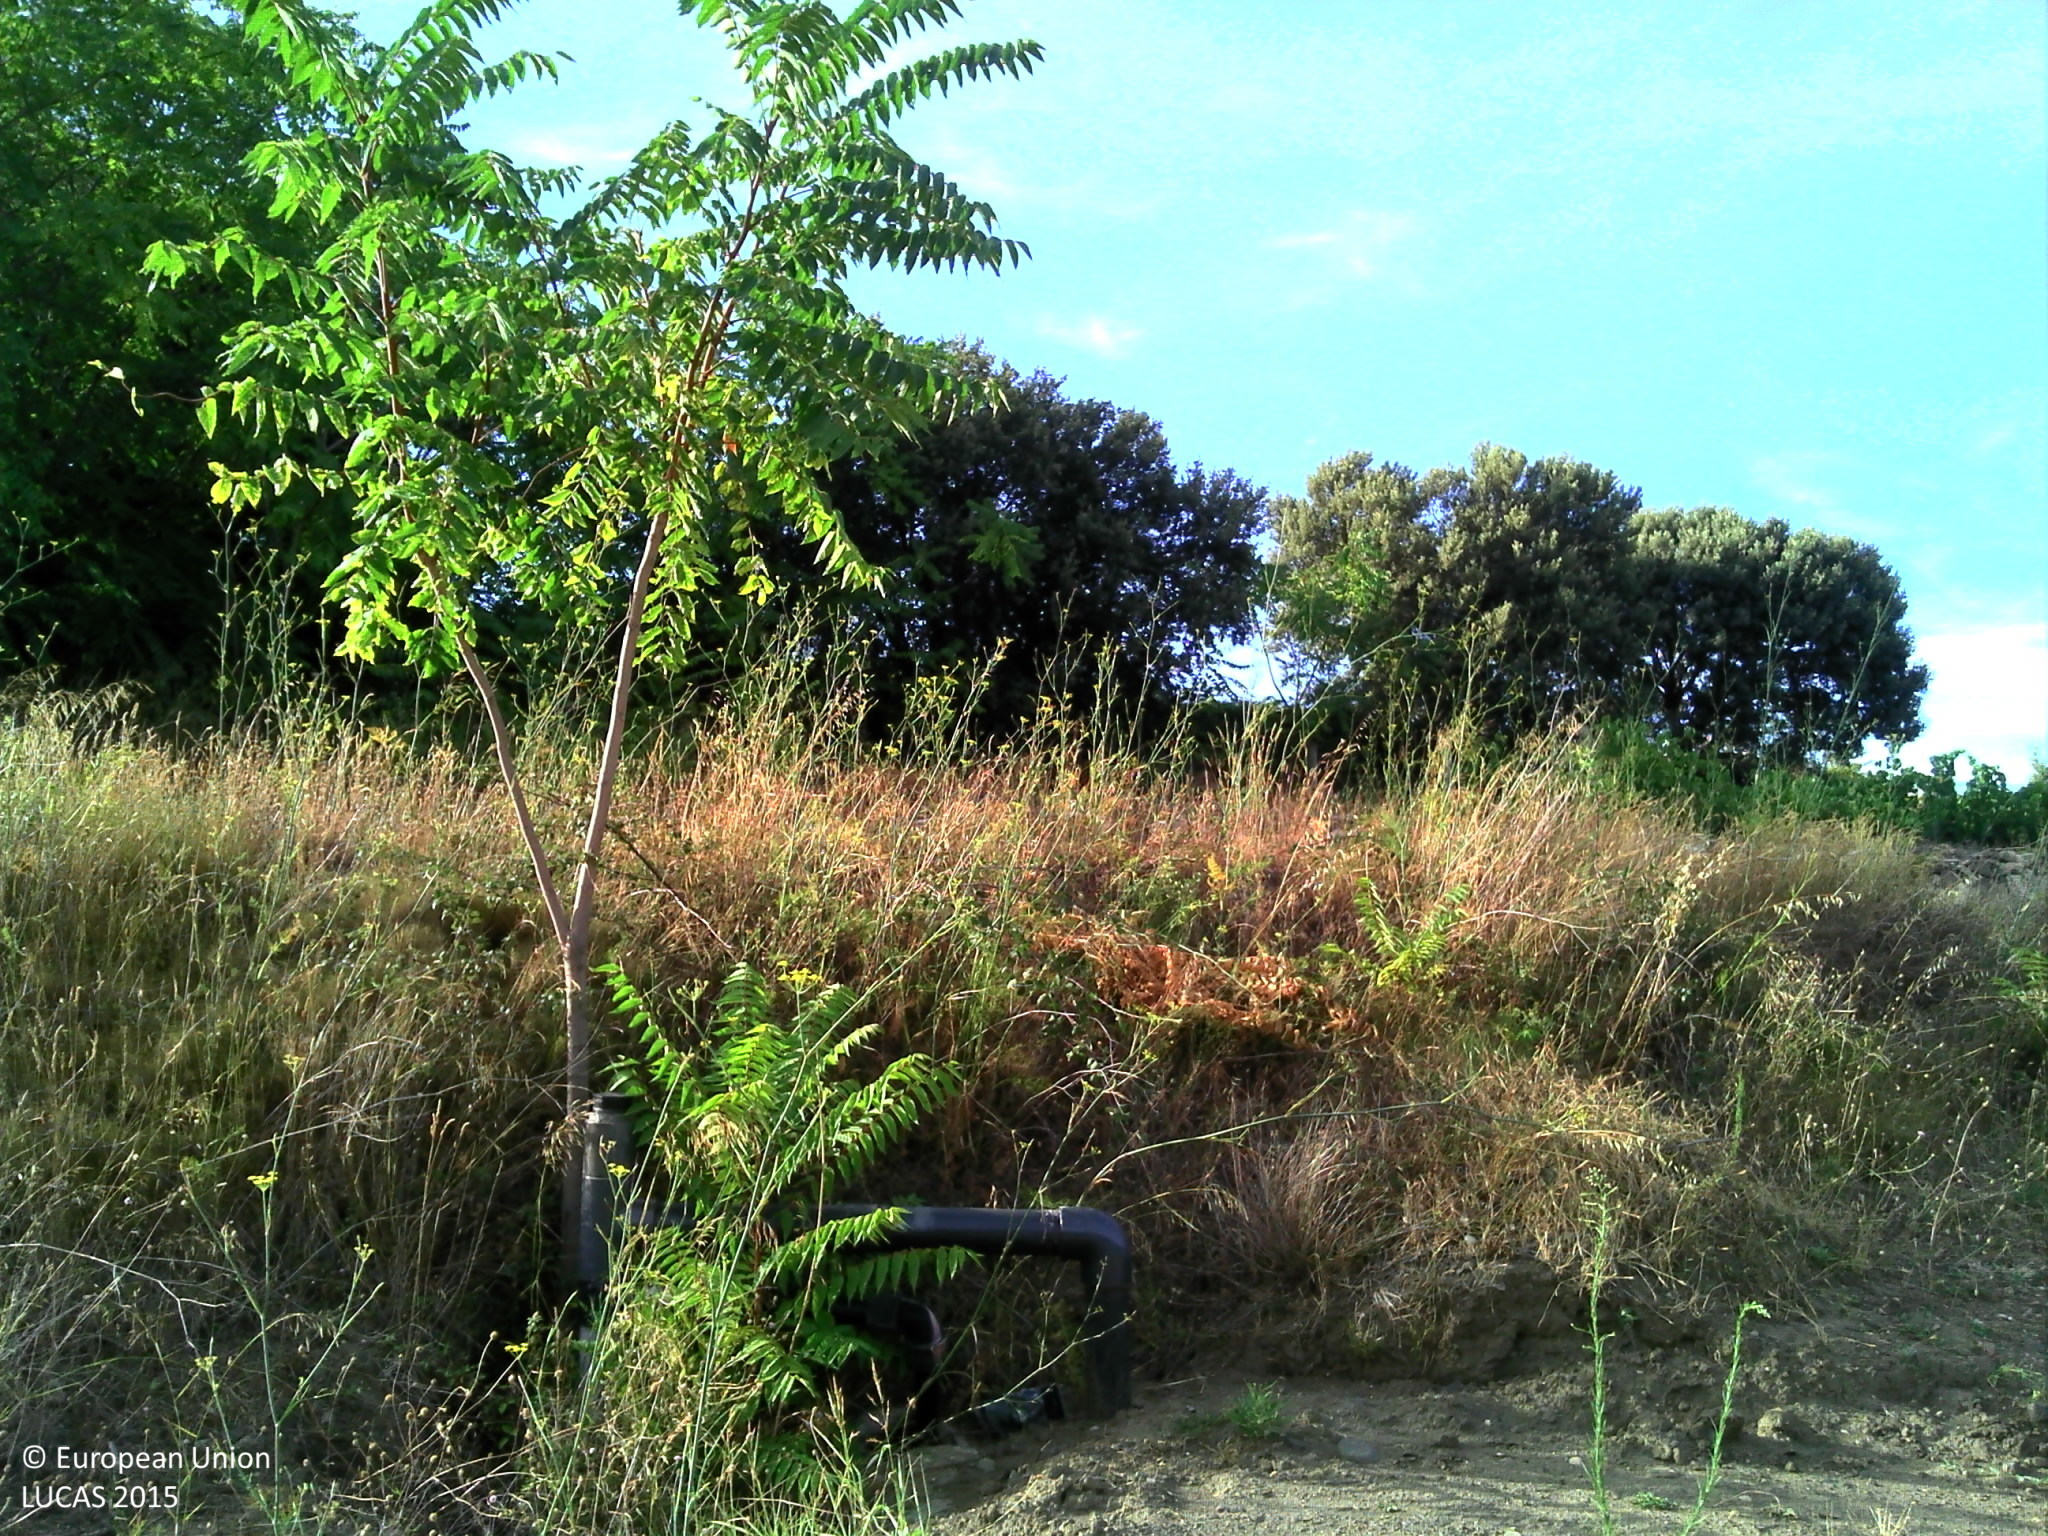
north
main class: Grassland
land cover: Spontaneously vegetated surfaces
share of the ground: > 75 %
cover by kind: unconsolidated bare surface 70 %, herbaceous plants 30 %
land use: Fallow land
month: July
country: FR
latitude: 42.7756
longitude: 2.7634
